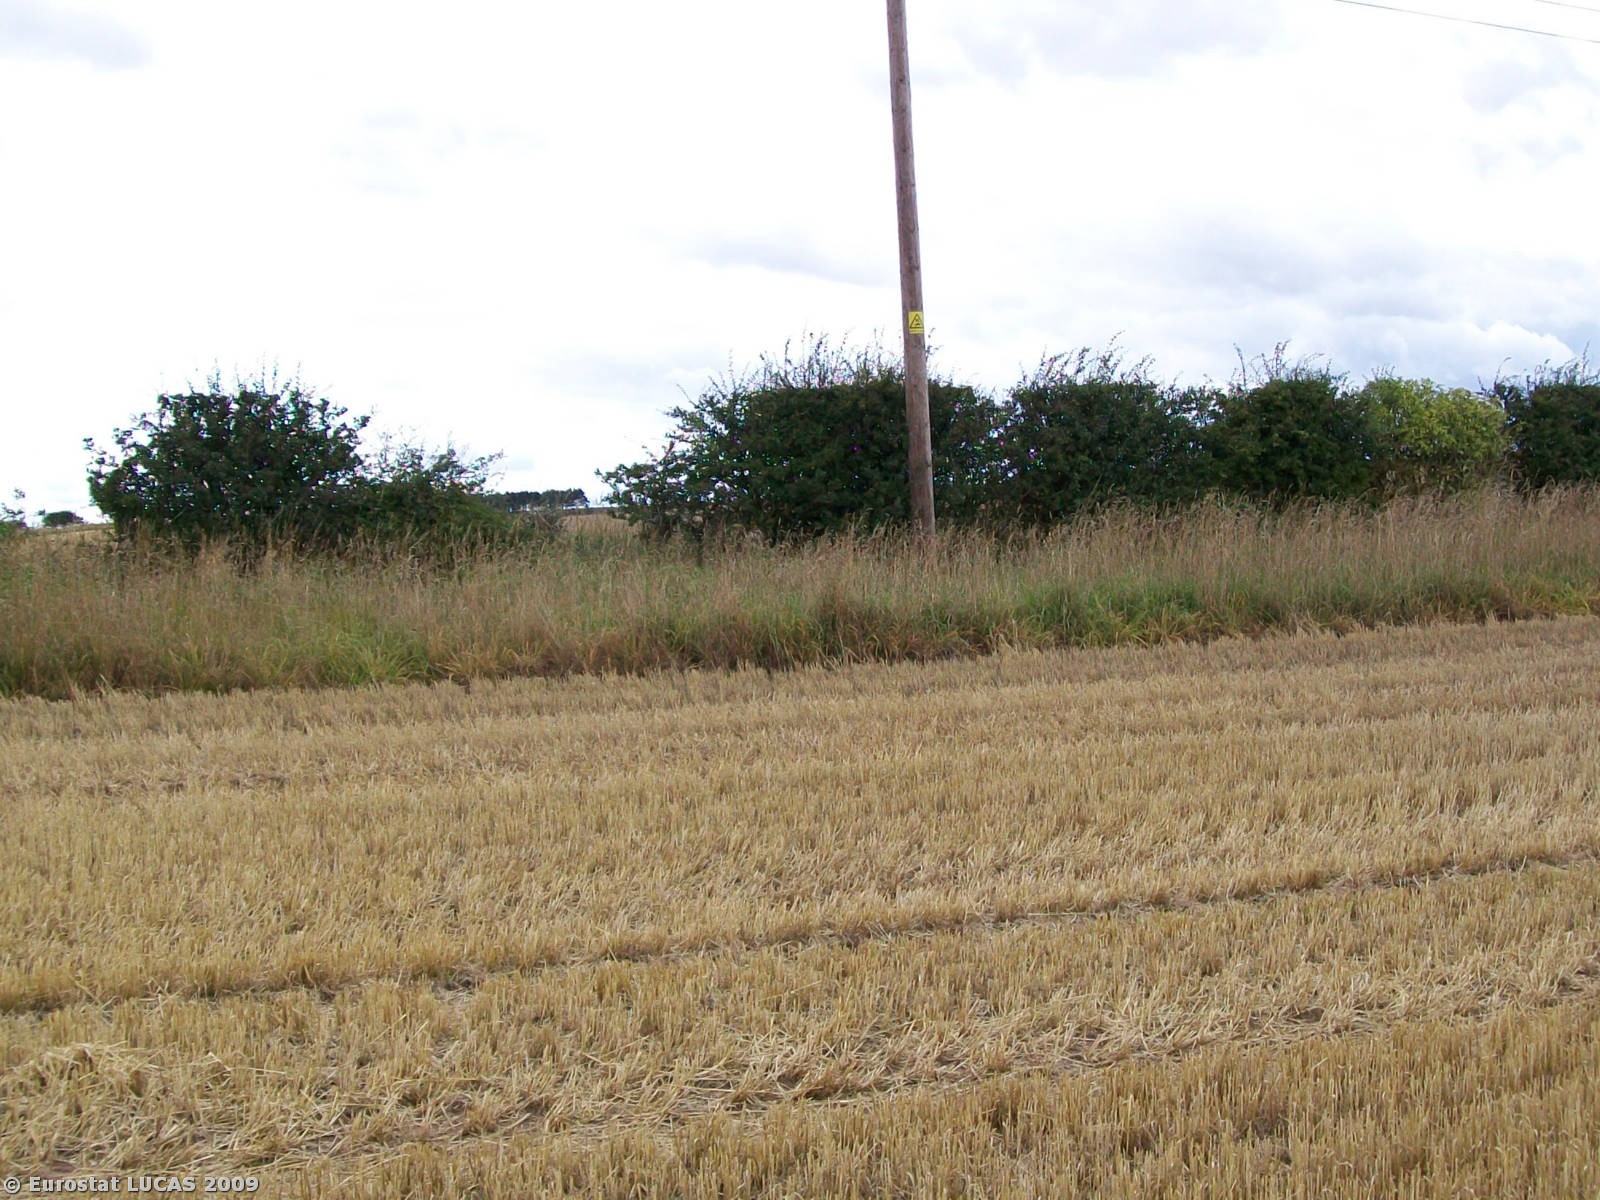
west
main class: Cropland
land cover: Barley
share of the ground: > 75 %
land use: Agriculture (excluding fallow land and kitchen gardens)
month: August
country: GB
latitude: 55.6324
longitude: -2.2717
